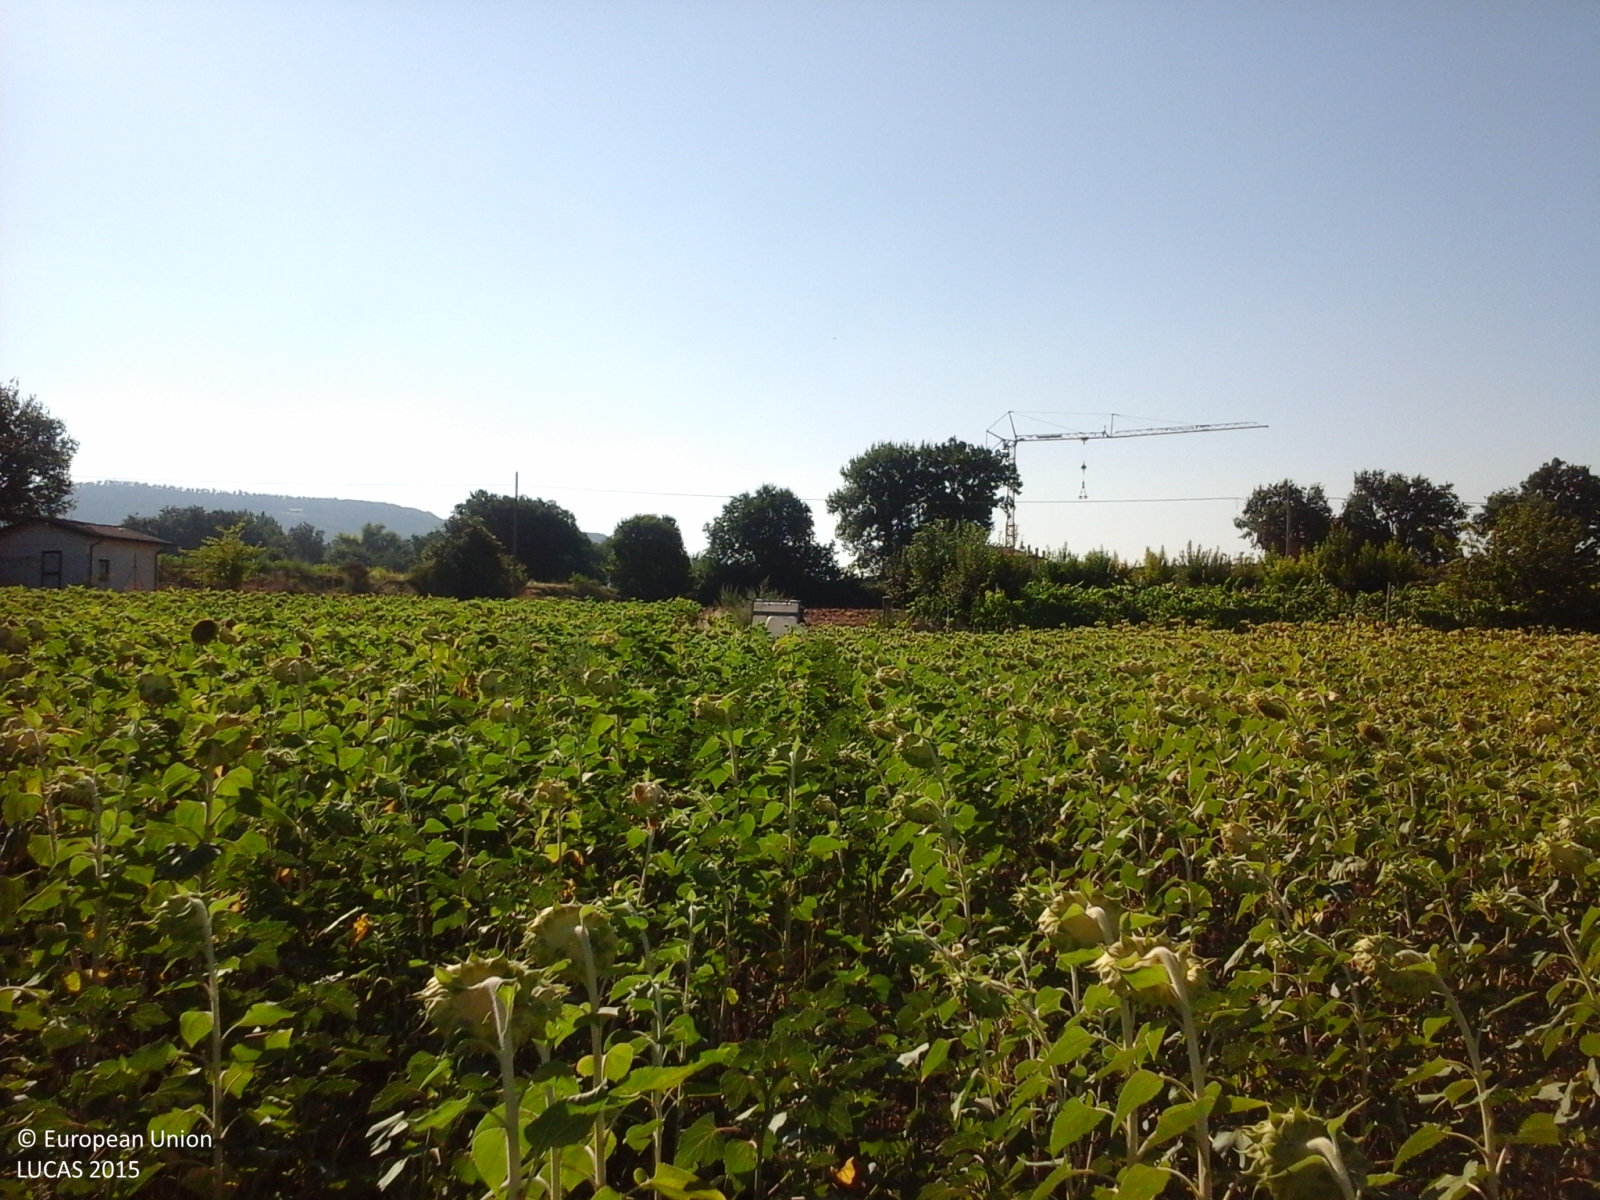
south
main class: Cropland
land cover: Sunflower
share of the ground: > 75 %
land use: Agriculture (excluding fallow land and kitchen gardens)
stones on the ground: < 10 %
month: August
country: IT
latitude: 43.5329
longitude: 12.2091
